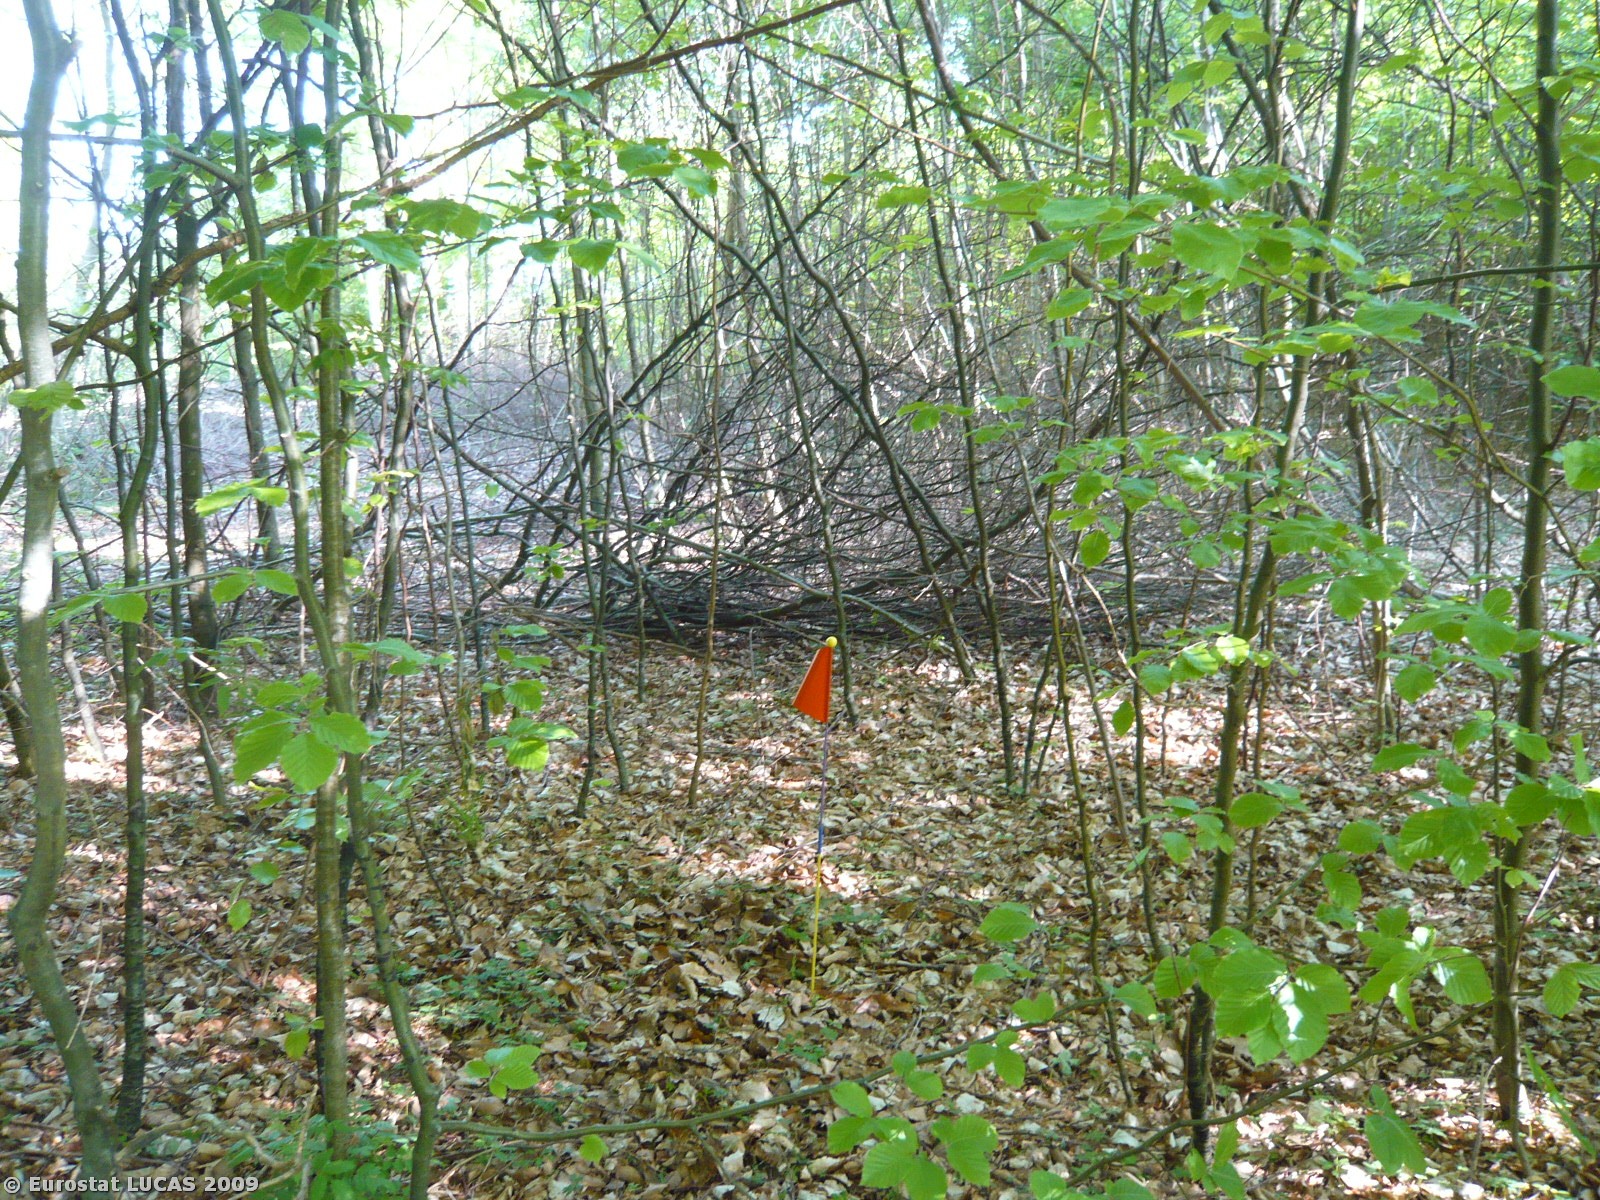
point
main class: Woodland
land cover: Broadleaved woodland
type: mesophytic deciduous forest
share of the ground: > 75 %
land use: Forestry
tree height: > 5 m
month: May
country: DK
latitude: 55.0920
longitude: 12.0825
